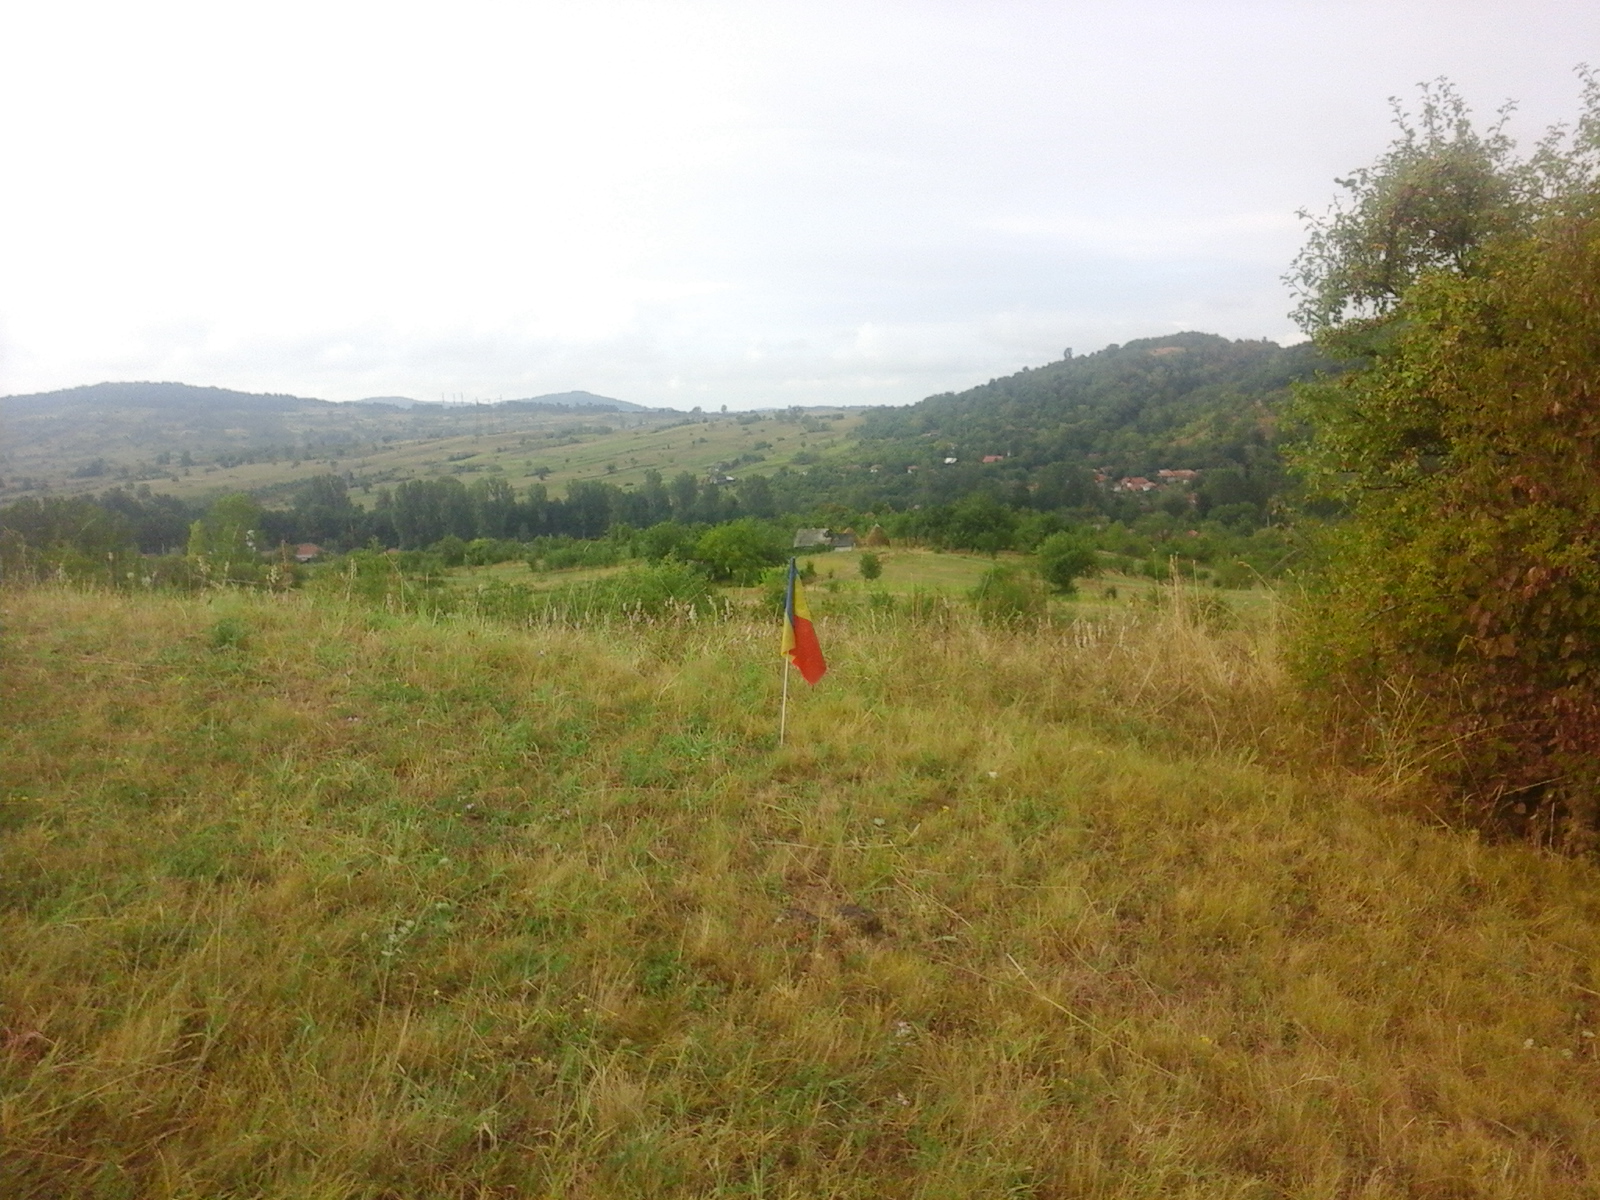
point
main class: Grassland
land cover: Grassland with sparse tree/shrub cover
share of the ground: > 75 %
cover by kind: herbaceous plants 95 %, broadleaved forest trees 5 %
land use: Agriculture (excluding fallow land and kitchen gardens)
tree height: < 5 m
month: August
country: RO
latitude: 44.8863
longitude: 22.7949
